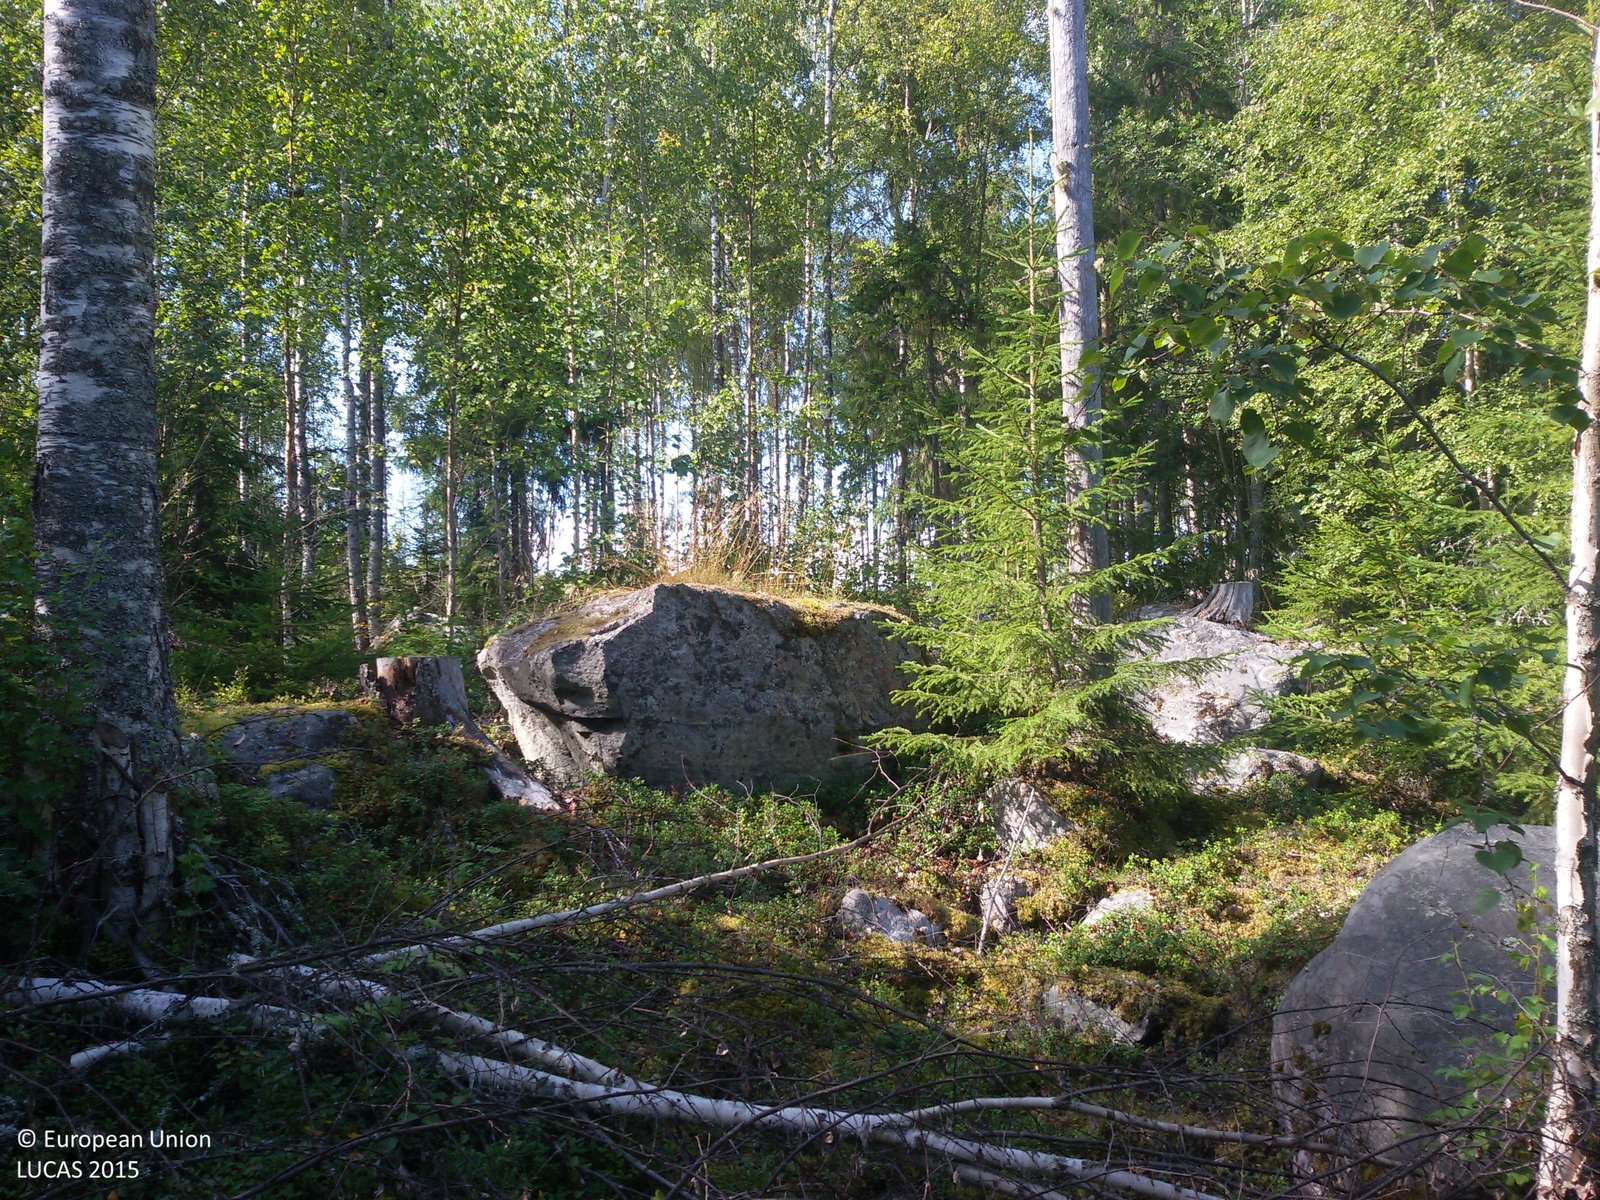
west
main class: Woodland
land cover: Broadleaved woodland
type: boreal forest
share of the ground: 50 - 75 %
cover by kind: broadleaved forest trees 65 %, herbaceous plants 15 %, lichens and mosses 15 %, coniferous forest trees 5 %
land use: Forestry
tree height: > 5 m
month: August
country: SE
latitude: 60.7610
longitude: 15.9149
